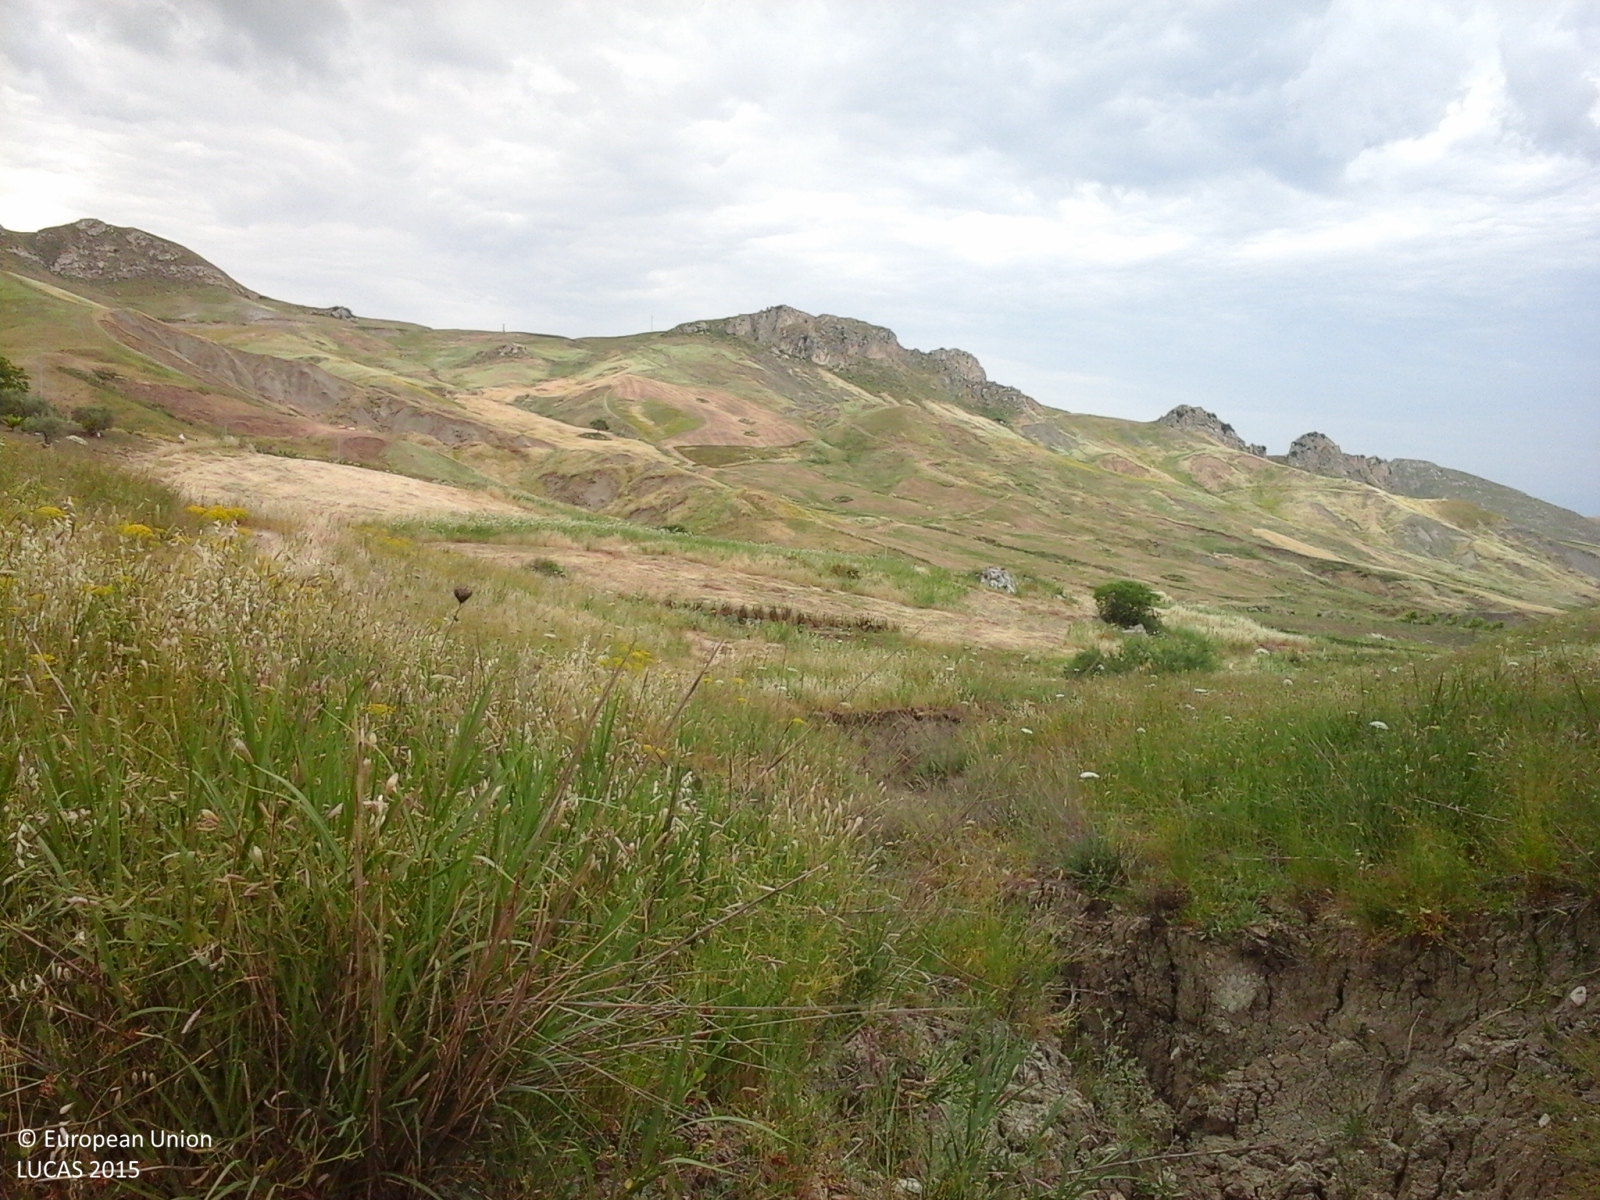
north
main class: Grassland
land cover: Grassland without tree/shrub cover
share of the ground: > 75 %
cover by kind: herbaceous plants 100 %
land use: Semi-natural and natural areas not in use
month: June
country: IT
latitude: 37.5511
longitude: 13.6288
